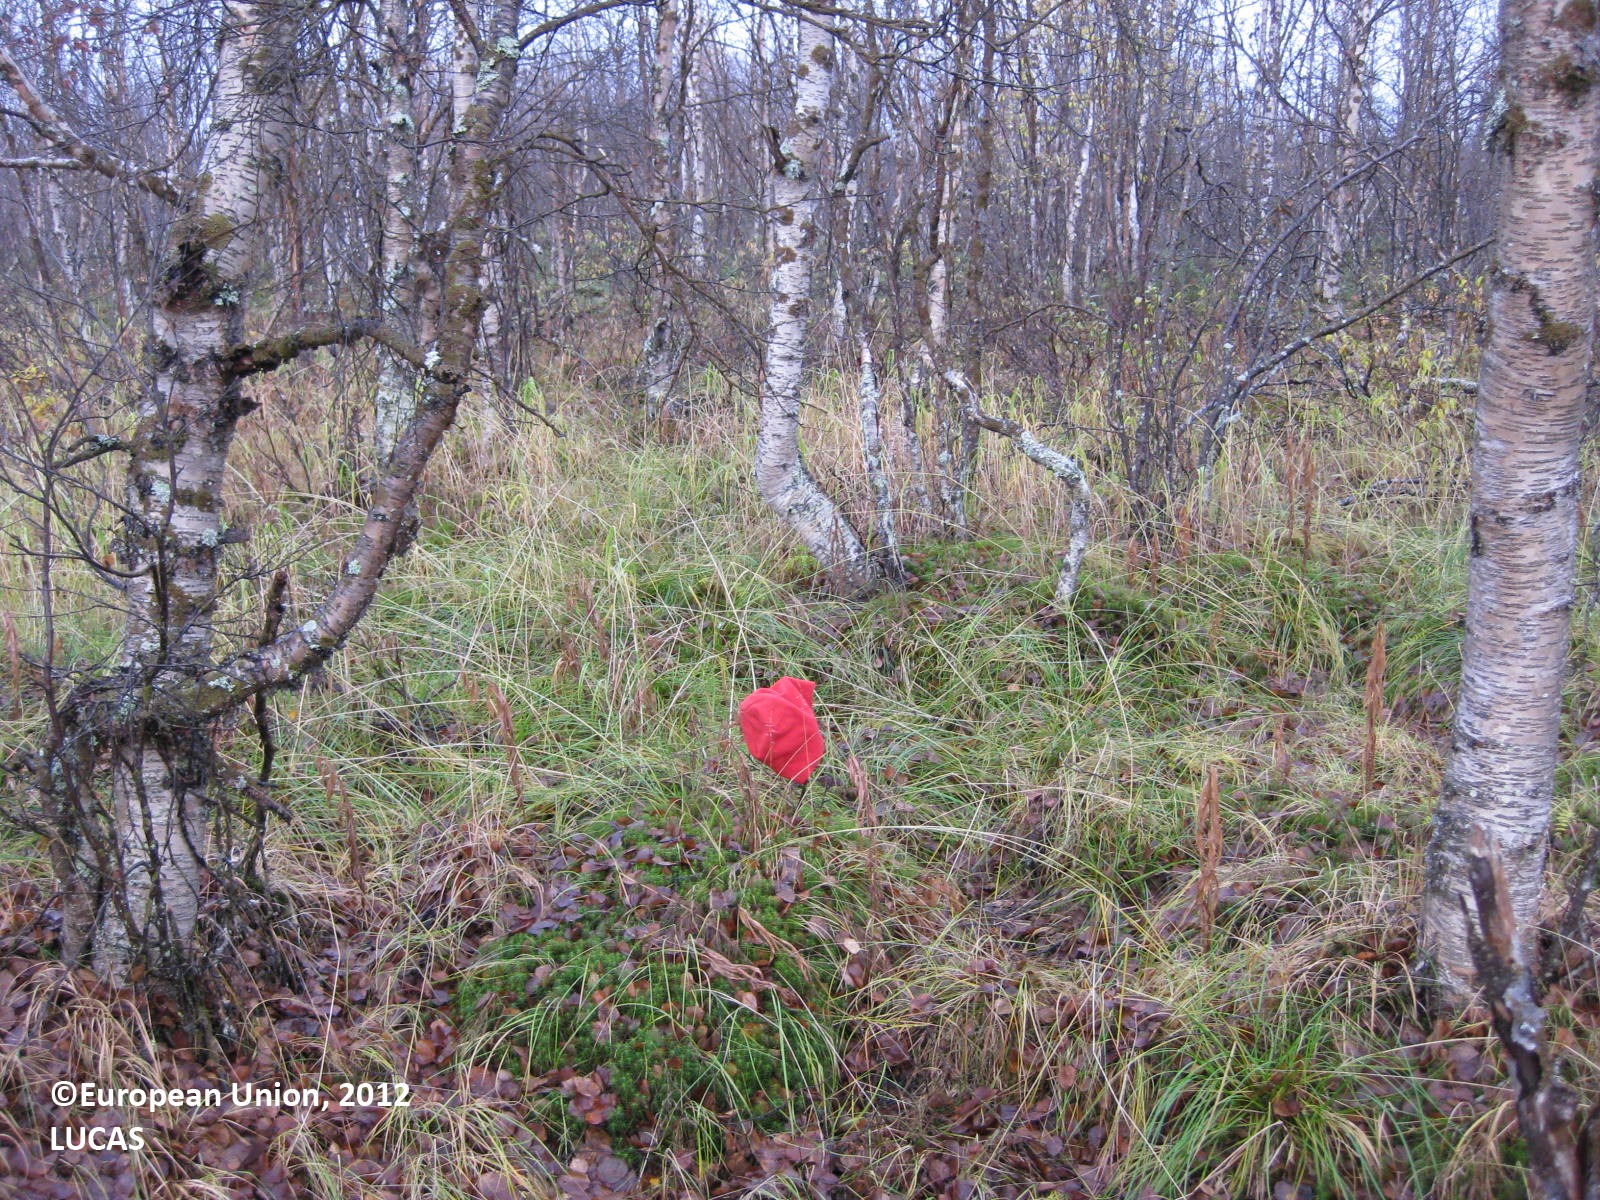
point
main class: Woodland
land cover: Broadleaved woodland
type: boreal forest
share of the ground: 50 - 75 %
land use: Forestry
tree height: > 5 m
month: September
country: FI
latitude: 68.4080
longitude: 23.9620
